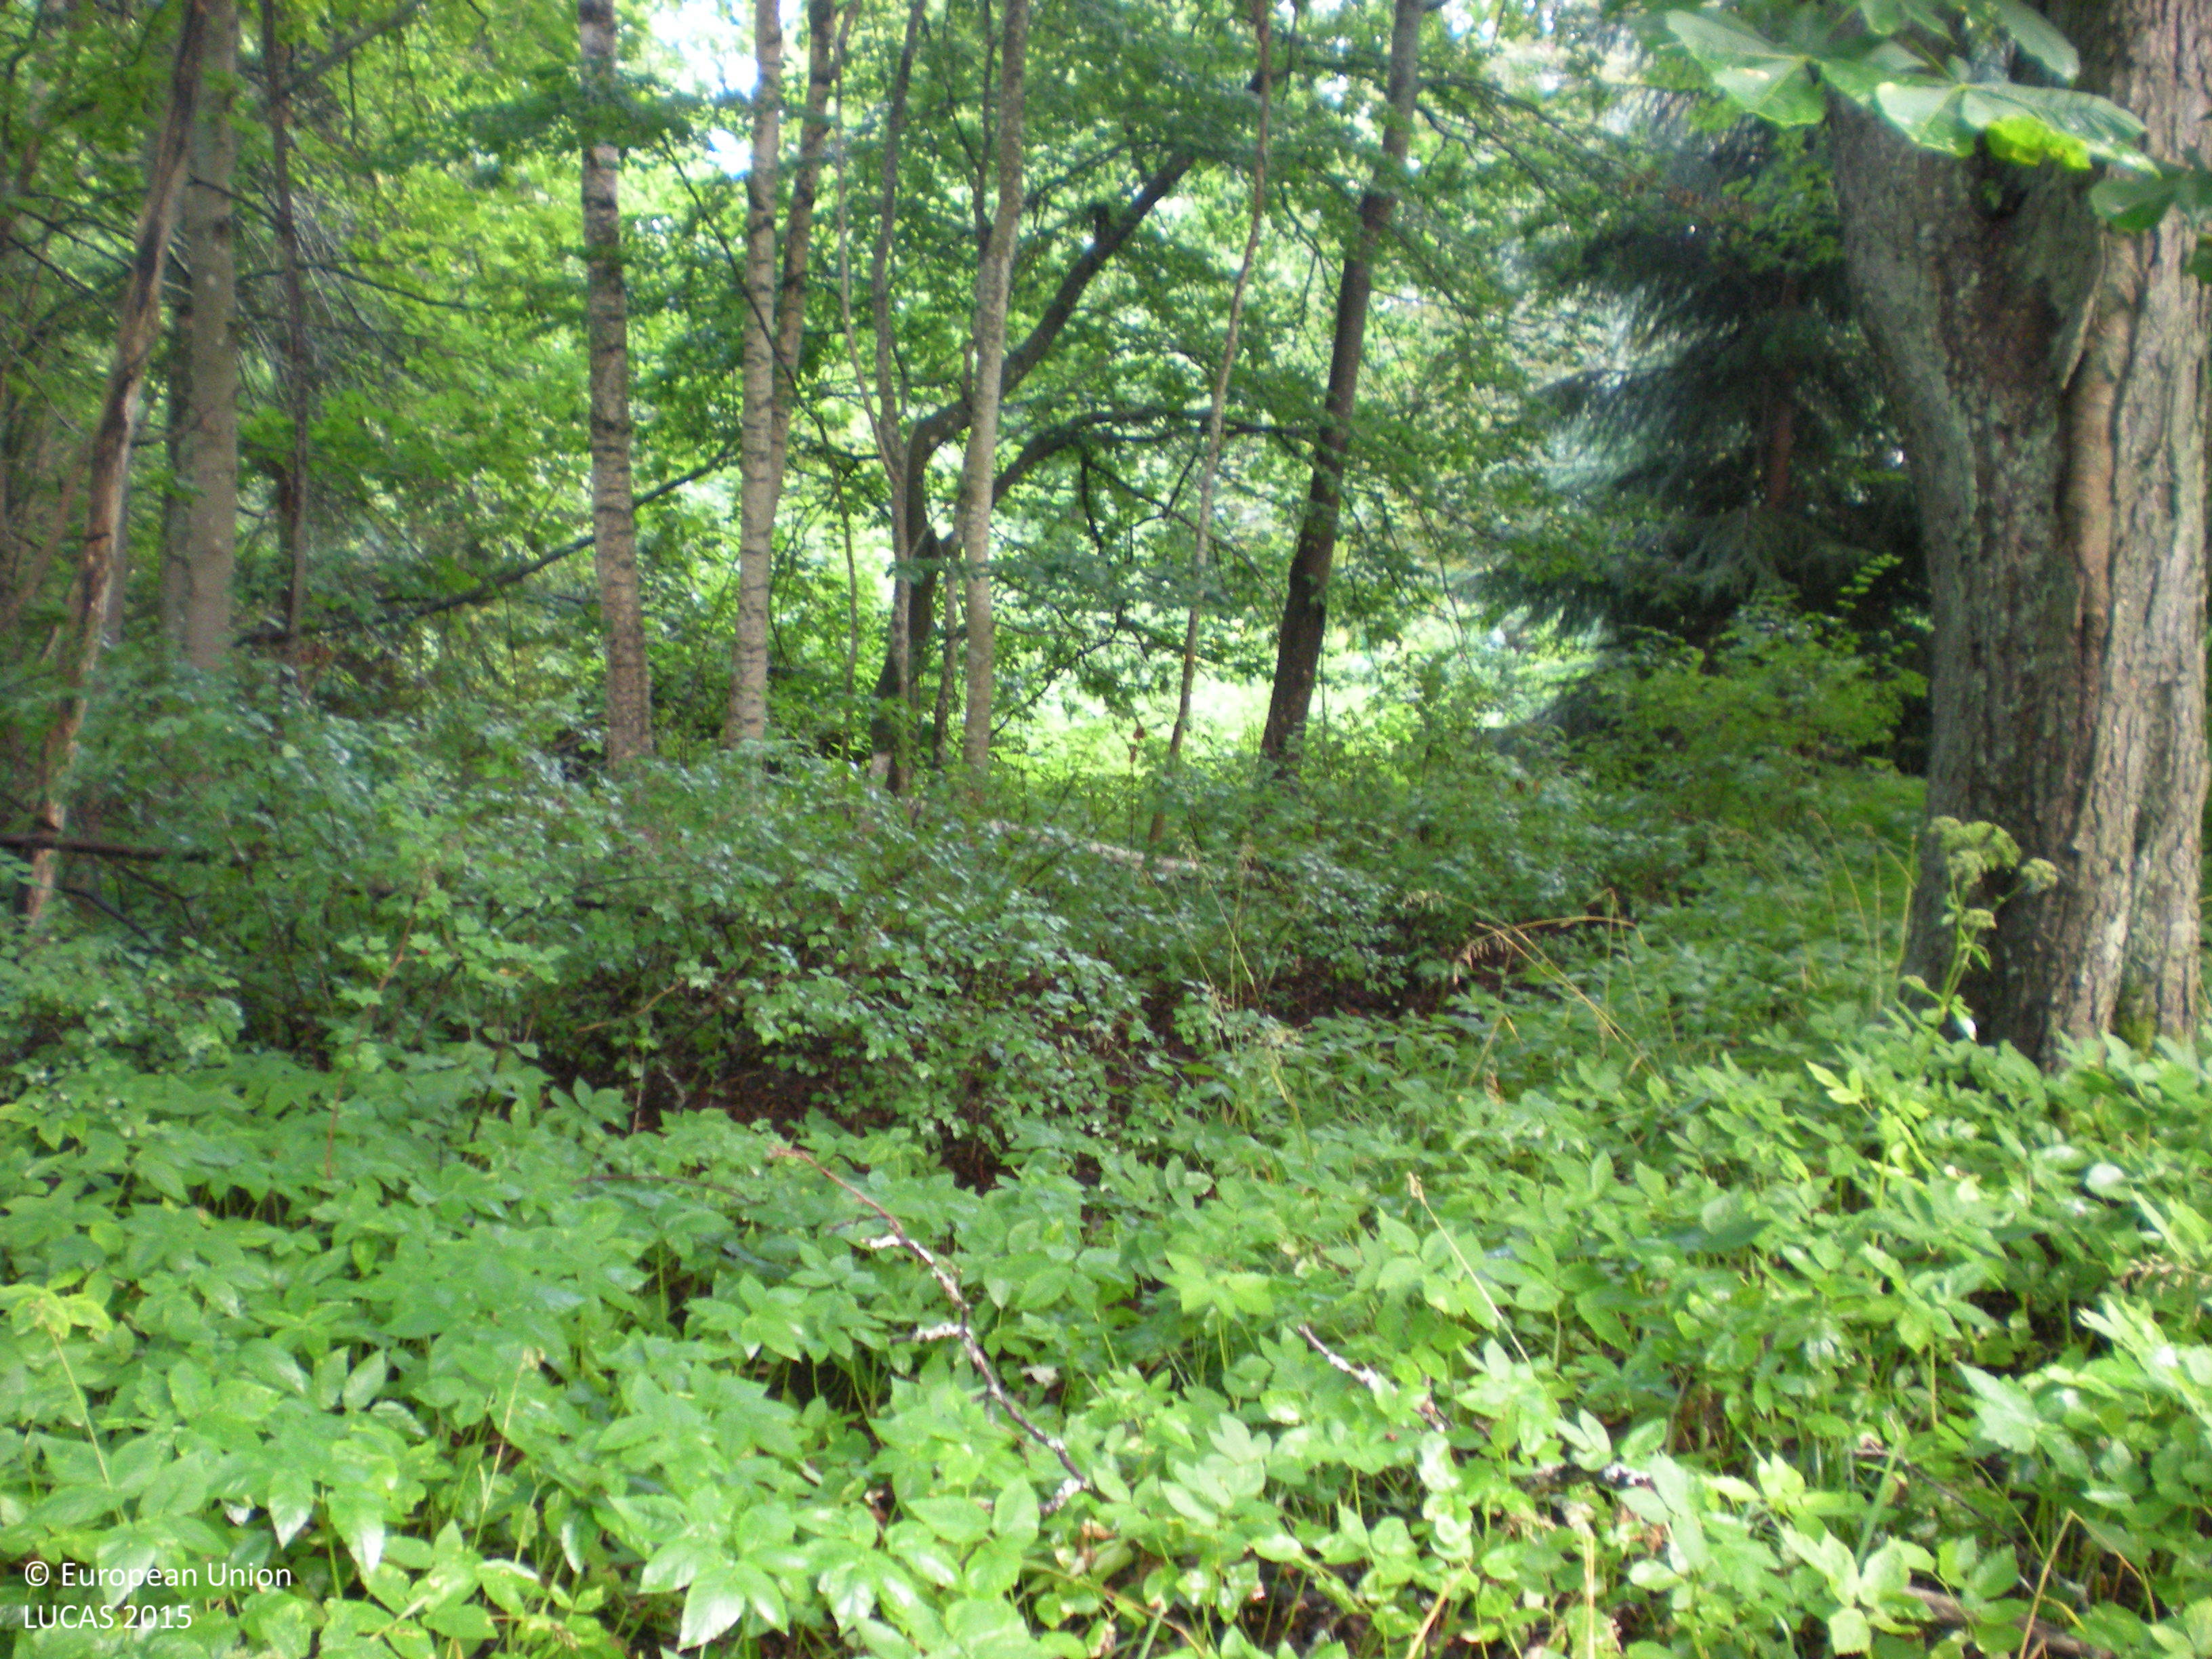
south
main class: Woodland
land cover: Broadleaved woodland
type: boreal forest
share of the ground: > 75 %
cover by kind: broadleaved forest trees 50 %, herbaceous plants 30 %, coniferous forest trees 10 %, lichens and mosses 5 %, unconsolidated bare surface 5 %
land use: Forestry
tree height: > 5 m
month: August
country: SE
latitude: 60.7009
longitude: 17.2251
